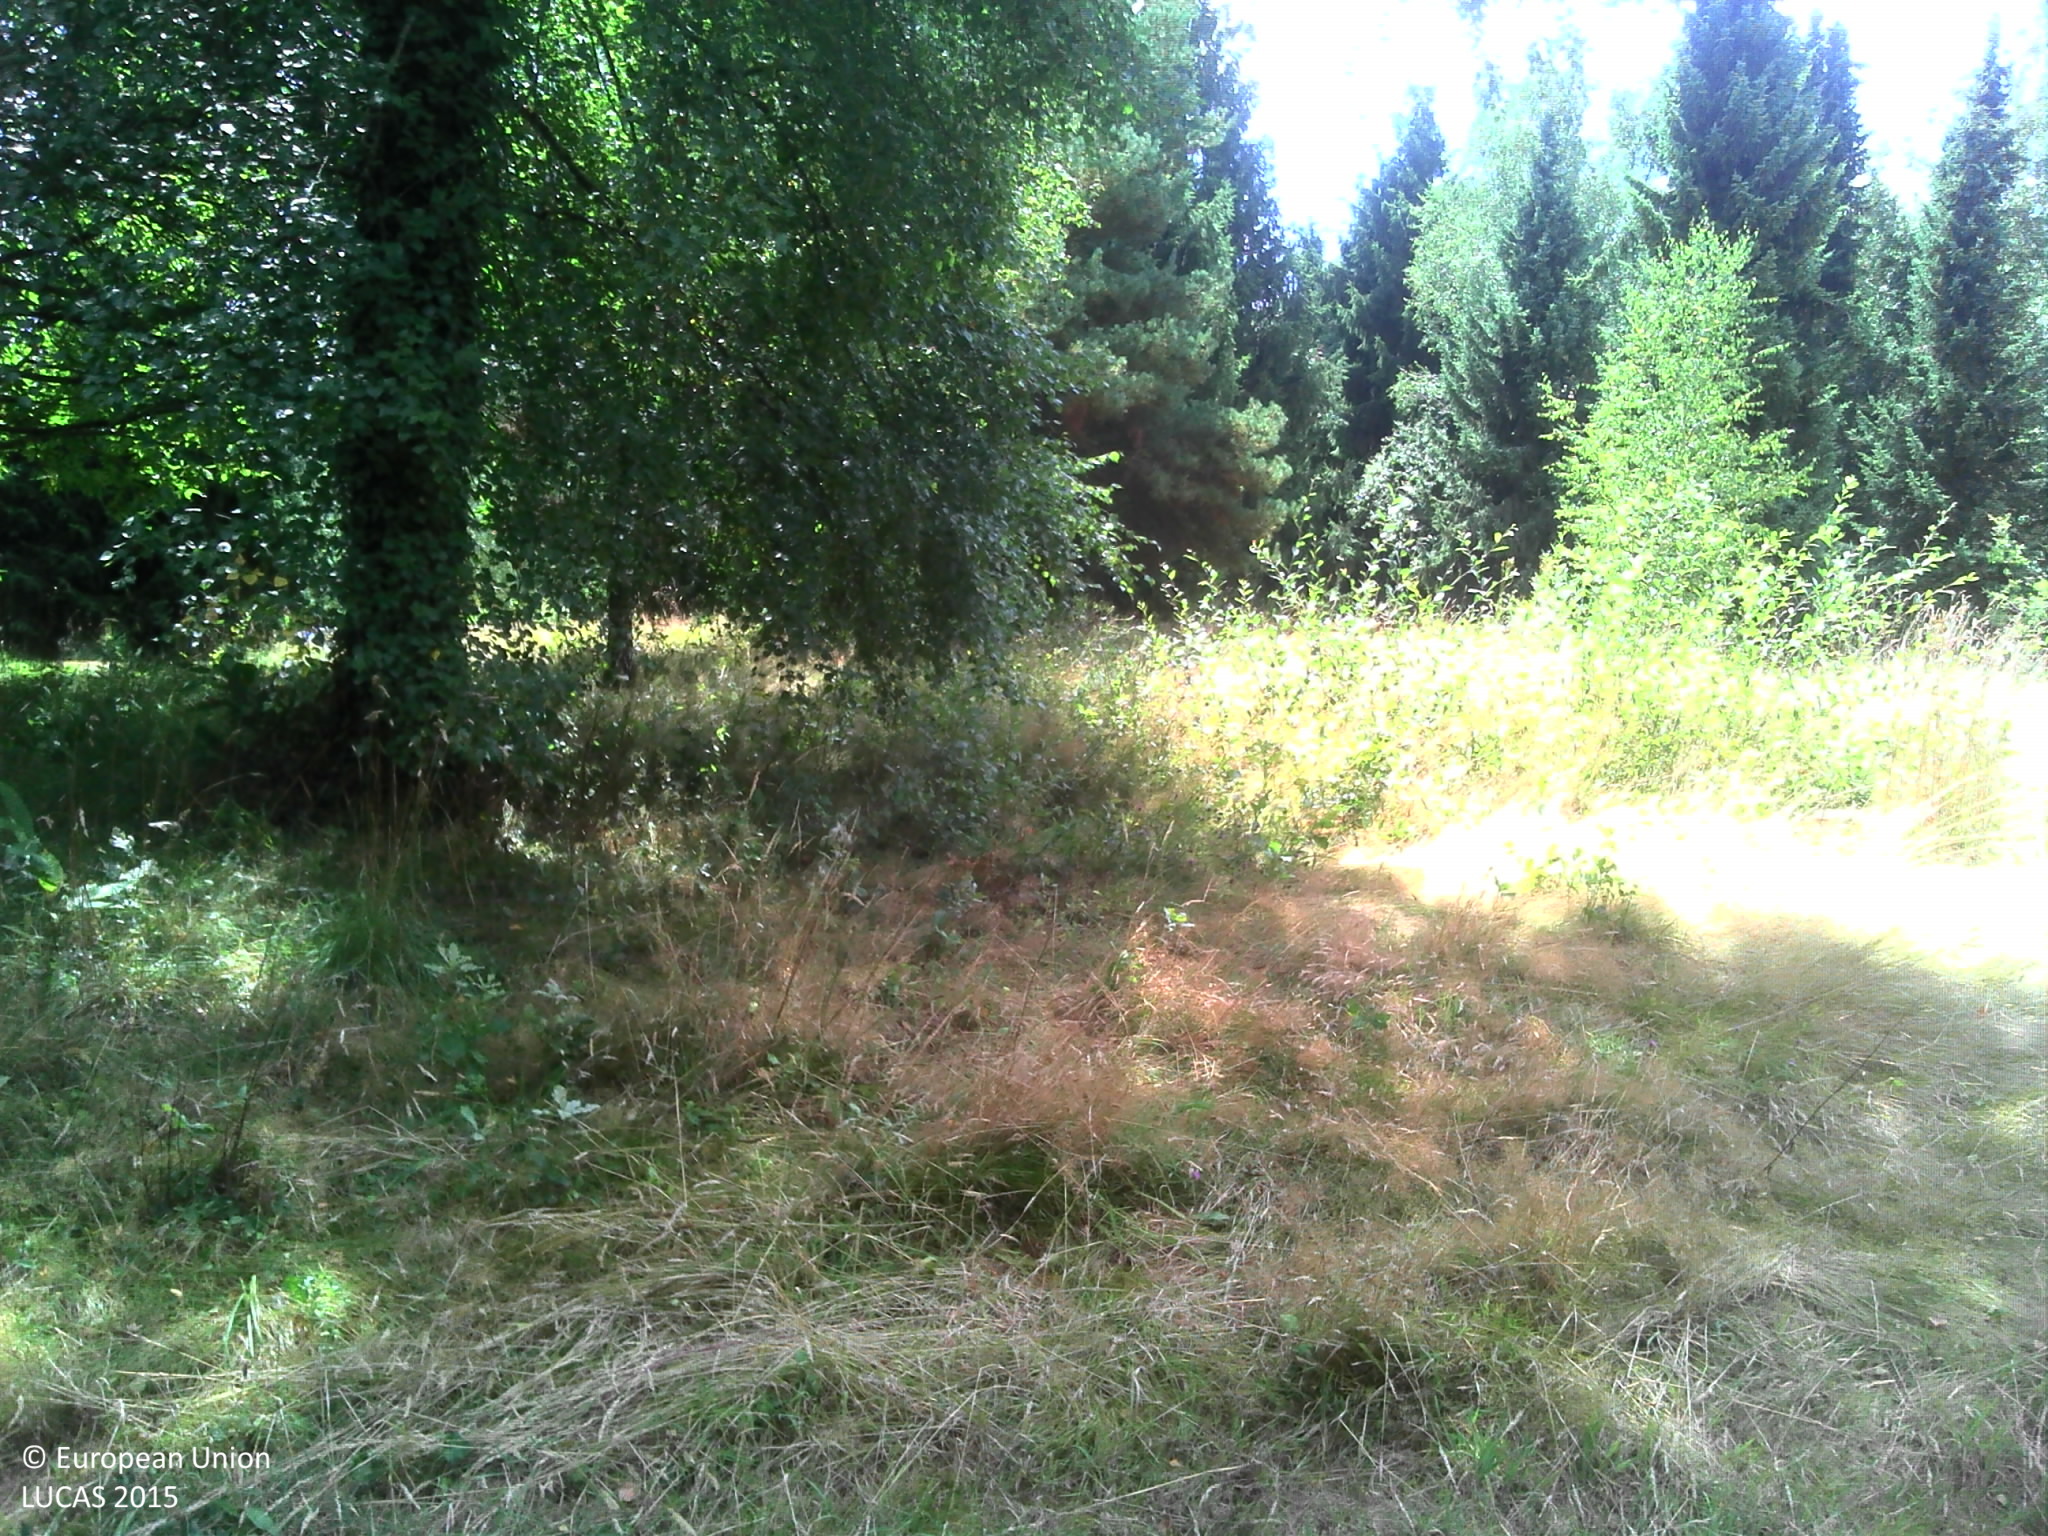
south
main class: Grassland
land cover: Grassland with sparse tree/shrub cover
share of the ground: > 75 %
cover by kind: herbaceous plants 85 %, shrubs 10 %, broadleaved forest trees 5 %
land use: Residential
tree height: > 5 m
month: August
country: FR
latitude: 46.7233
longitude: -1.3812
